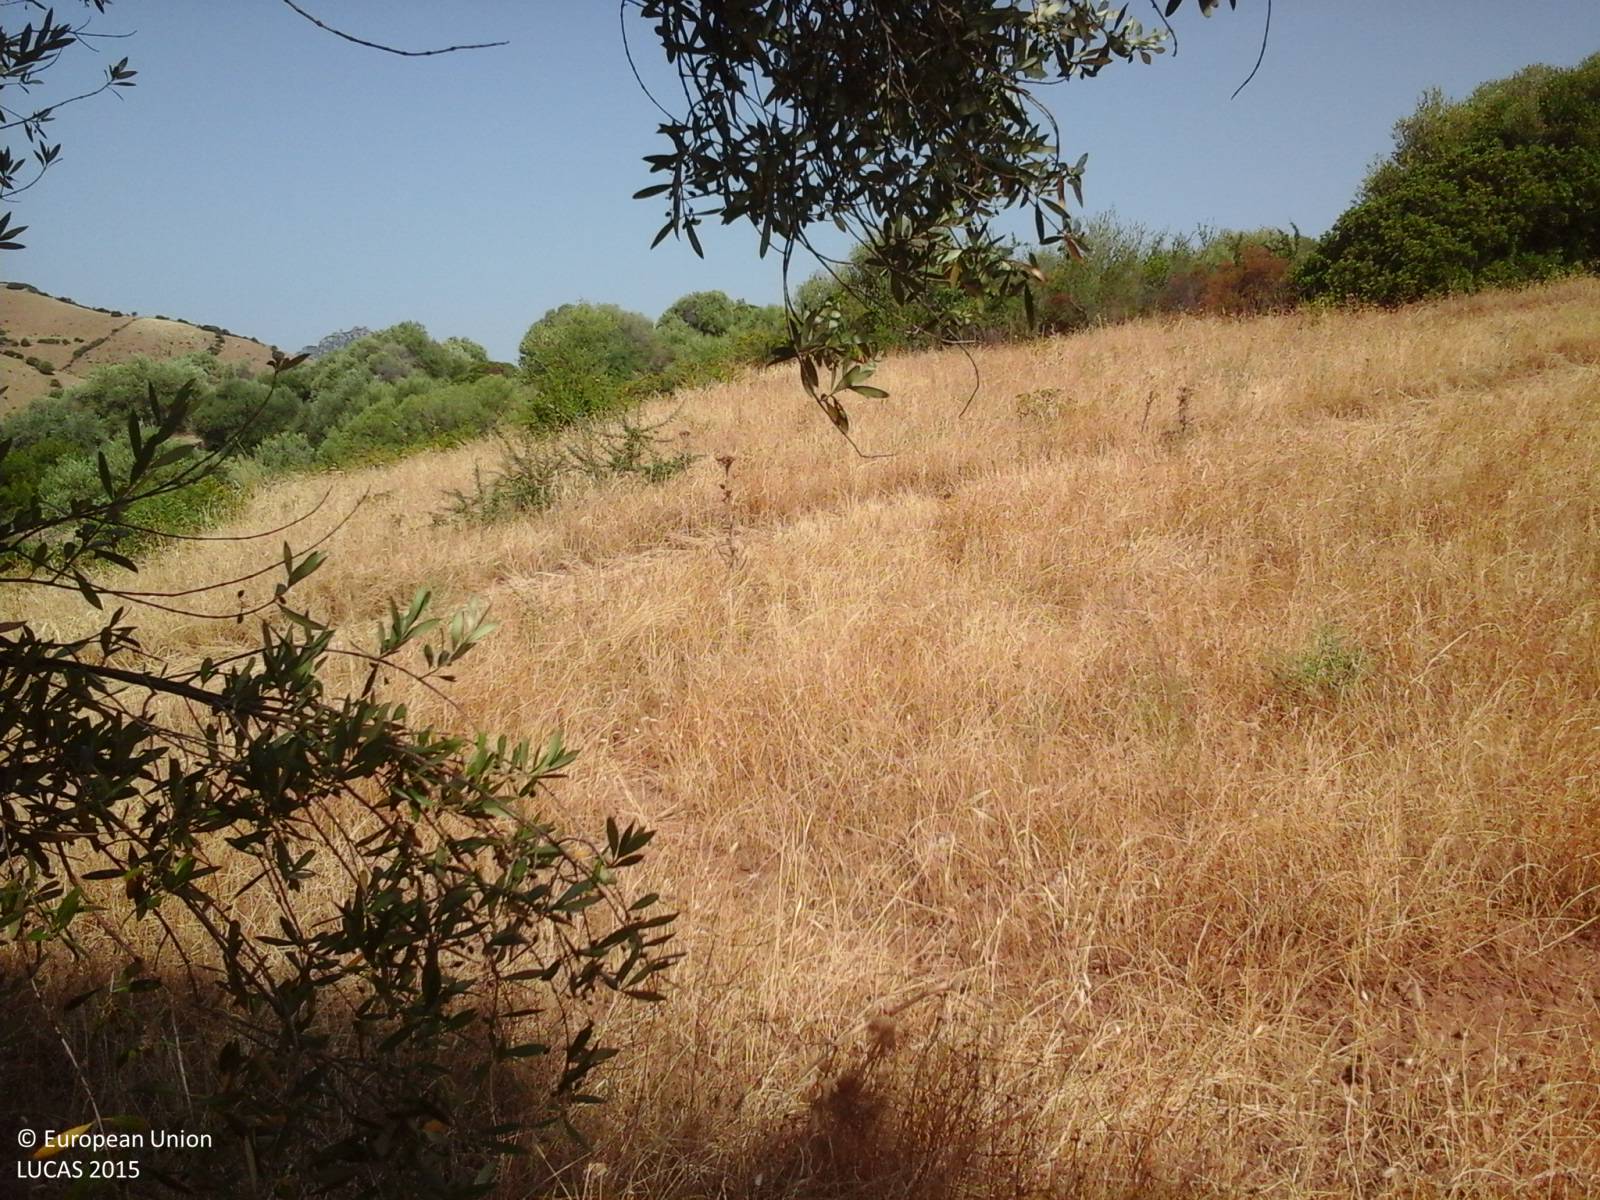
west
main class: Woodland
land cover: Broadleaved woodland
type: broadleaved evergreen forest
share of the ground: > 75 %
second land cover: Temporary grasslands
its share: > 75 %
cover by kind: broadleaved forest trees 95 %, herbaceous plants 5 %
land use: Forestry
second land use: Agriculture (excluding fallow land and kitchen gardens)
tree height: > 5 m
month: July
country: IT
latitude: 40.6283
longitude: 9.5647
